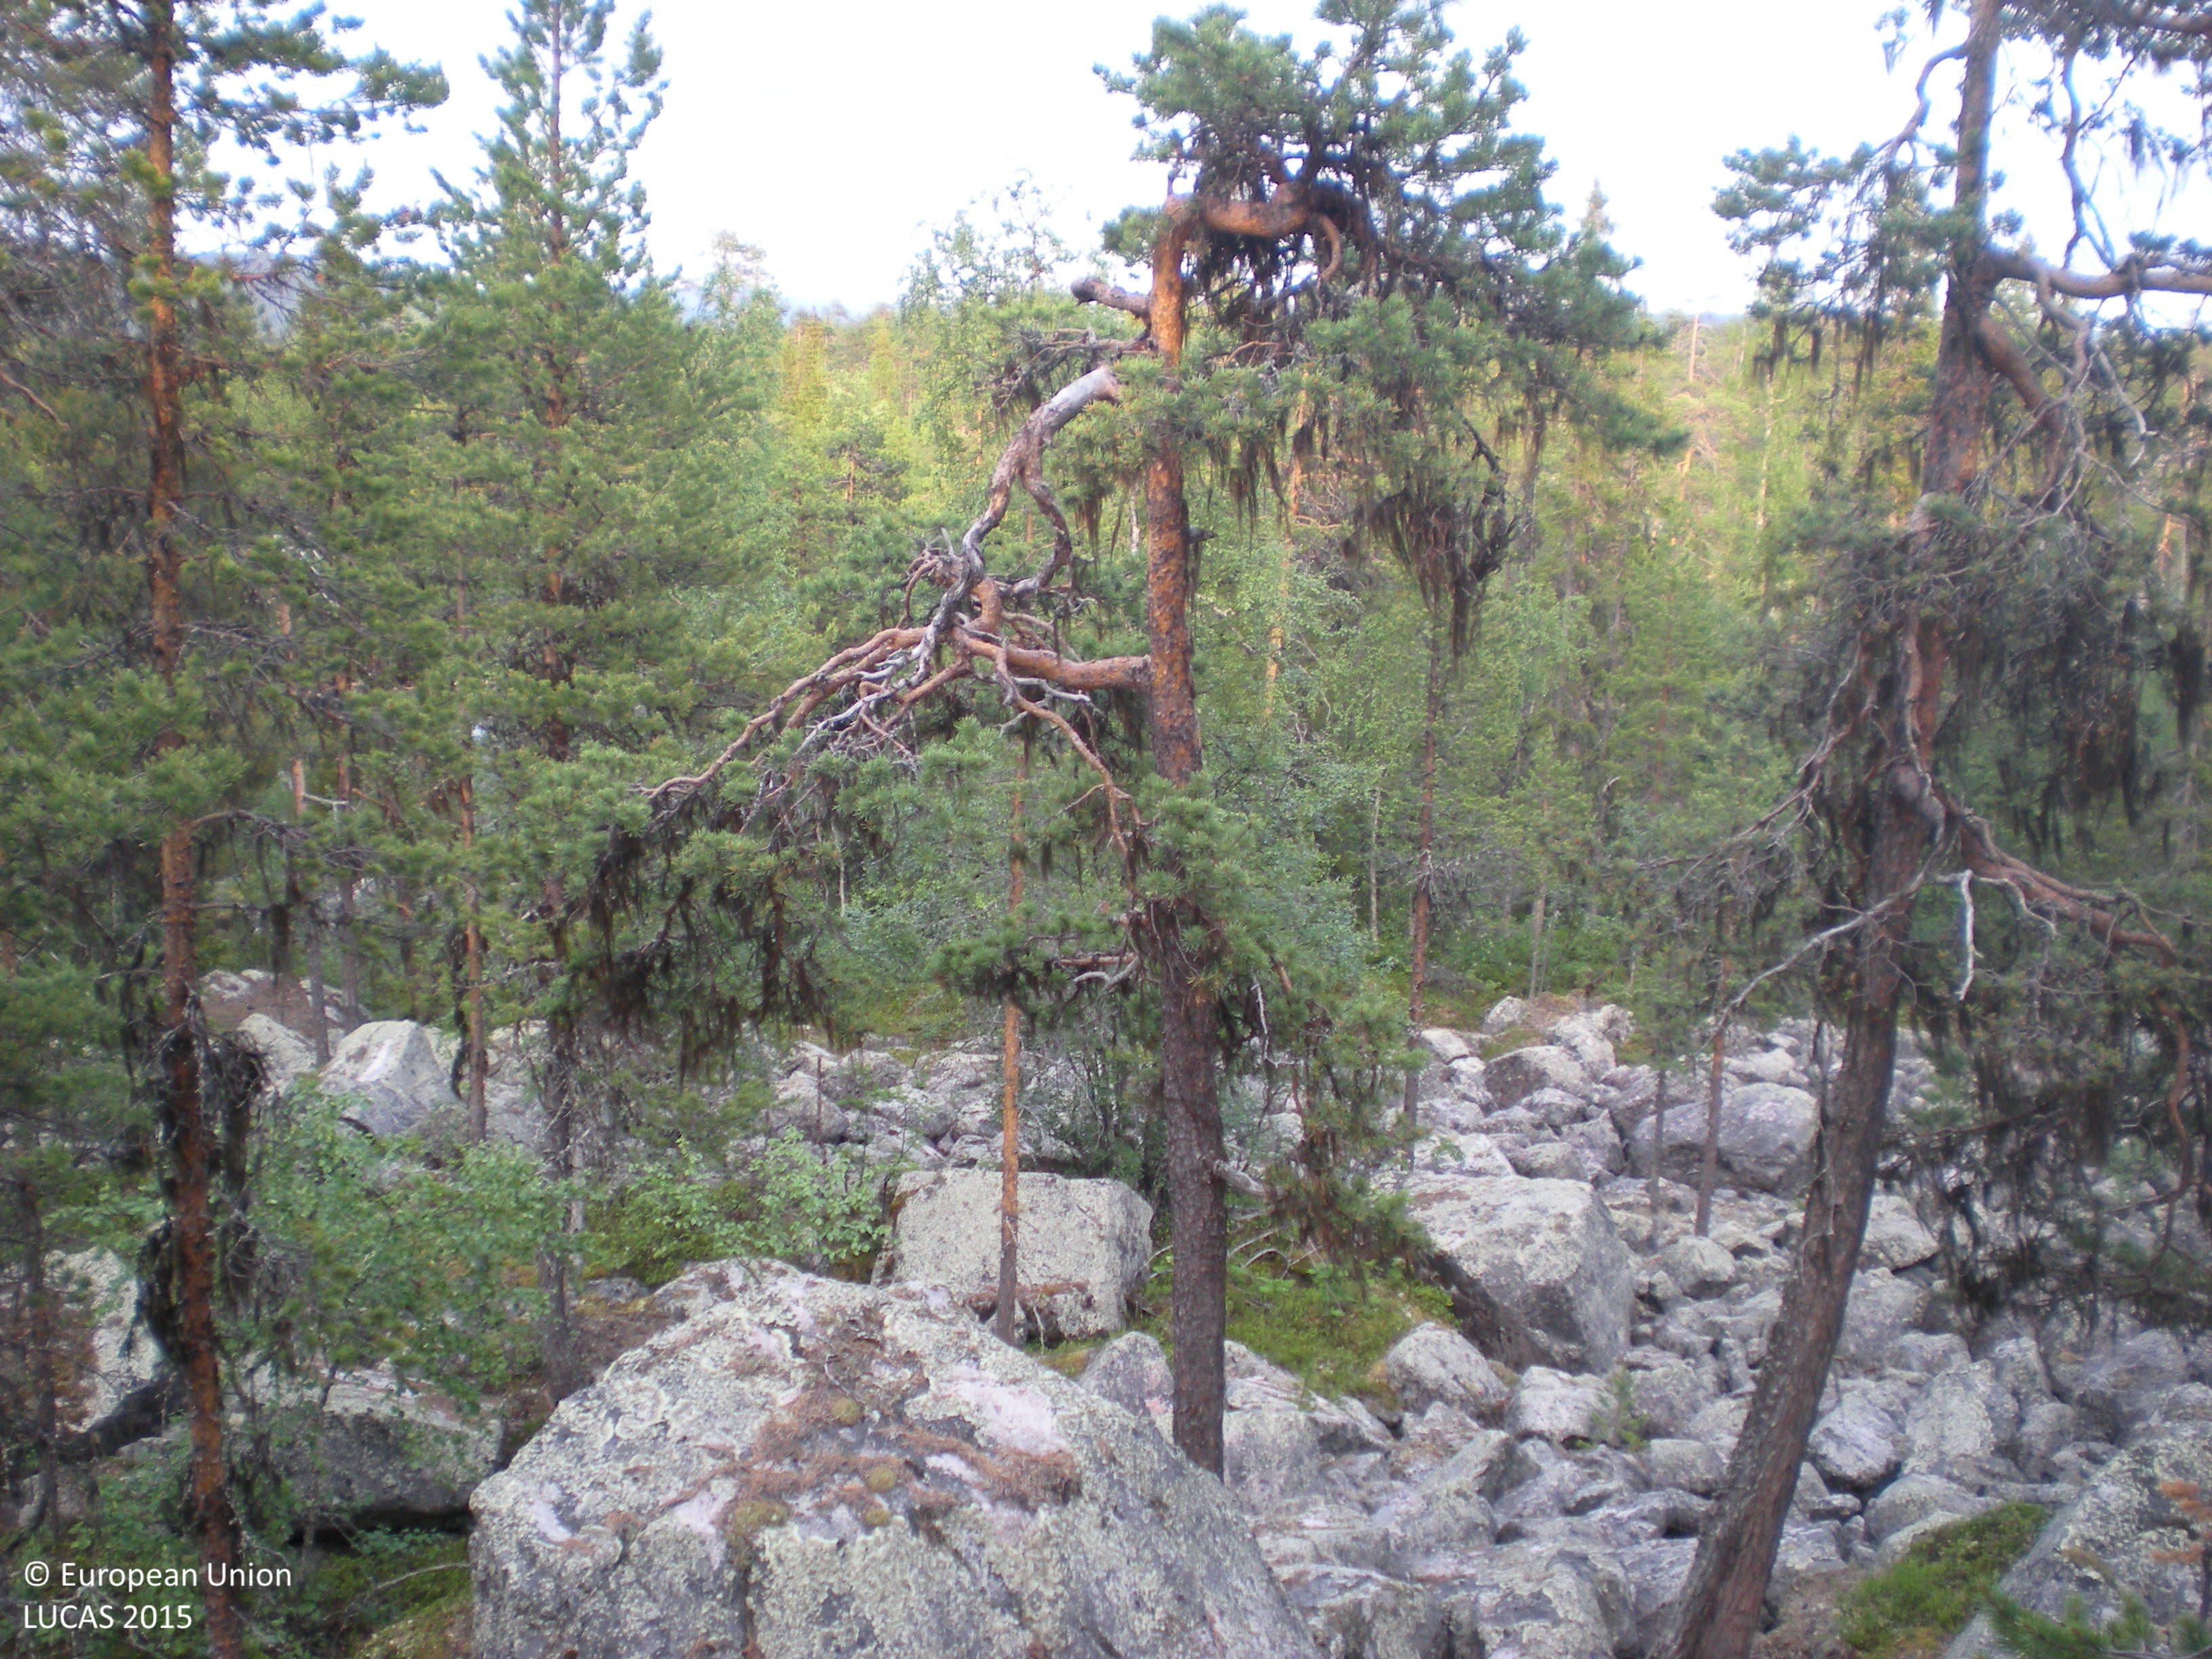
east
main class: Woodland
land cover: Pine dominated coniferous woodland
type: boreal forest
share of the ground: 10 - 25 %
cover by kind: consolidated bare surface 70 %, coniferous forest trees 15 %, shrubs 10 %, broadleaved forest trees 5 %
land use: Semi-natural and natural areas not in use
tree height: > 5 m
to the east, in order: Pine dominated coniferous woodland; Rocks and stones; Pine dominated mixed woodland; Rocks and stones; Other mixed woodland; Inland fresh water bodies; Spruce dominated mixed woodland; Pine dominated mixed woodland
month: July
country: SE
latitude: 65.6923
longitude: 17.0781
